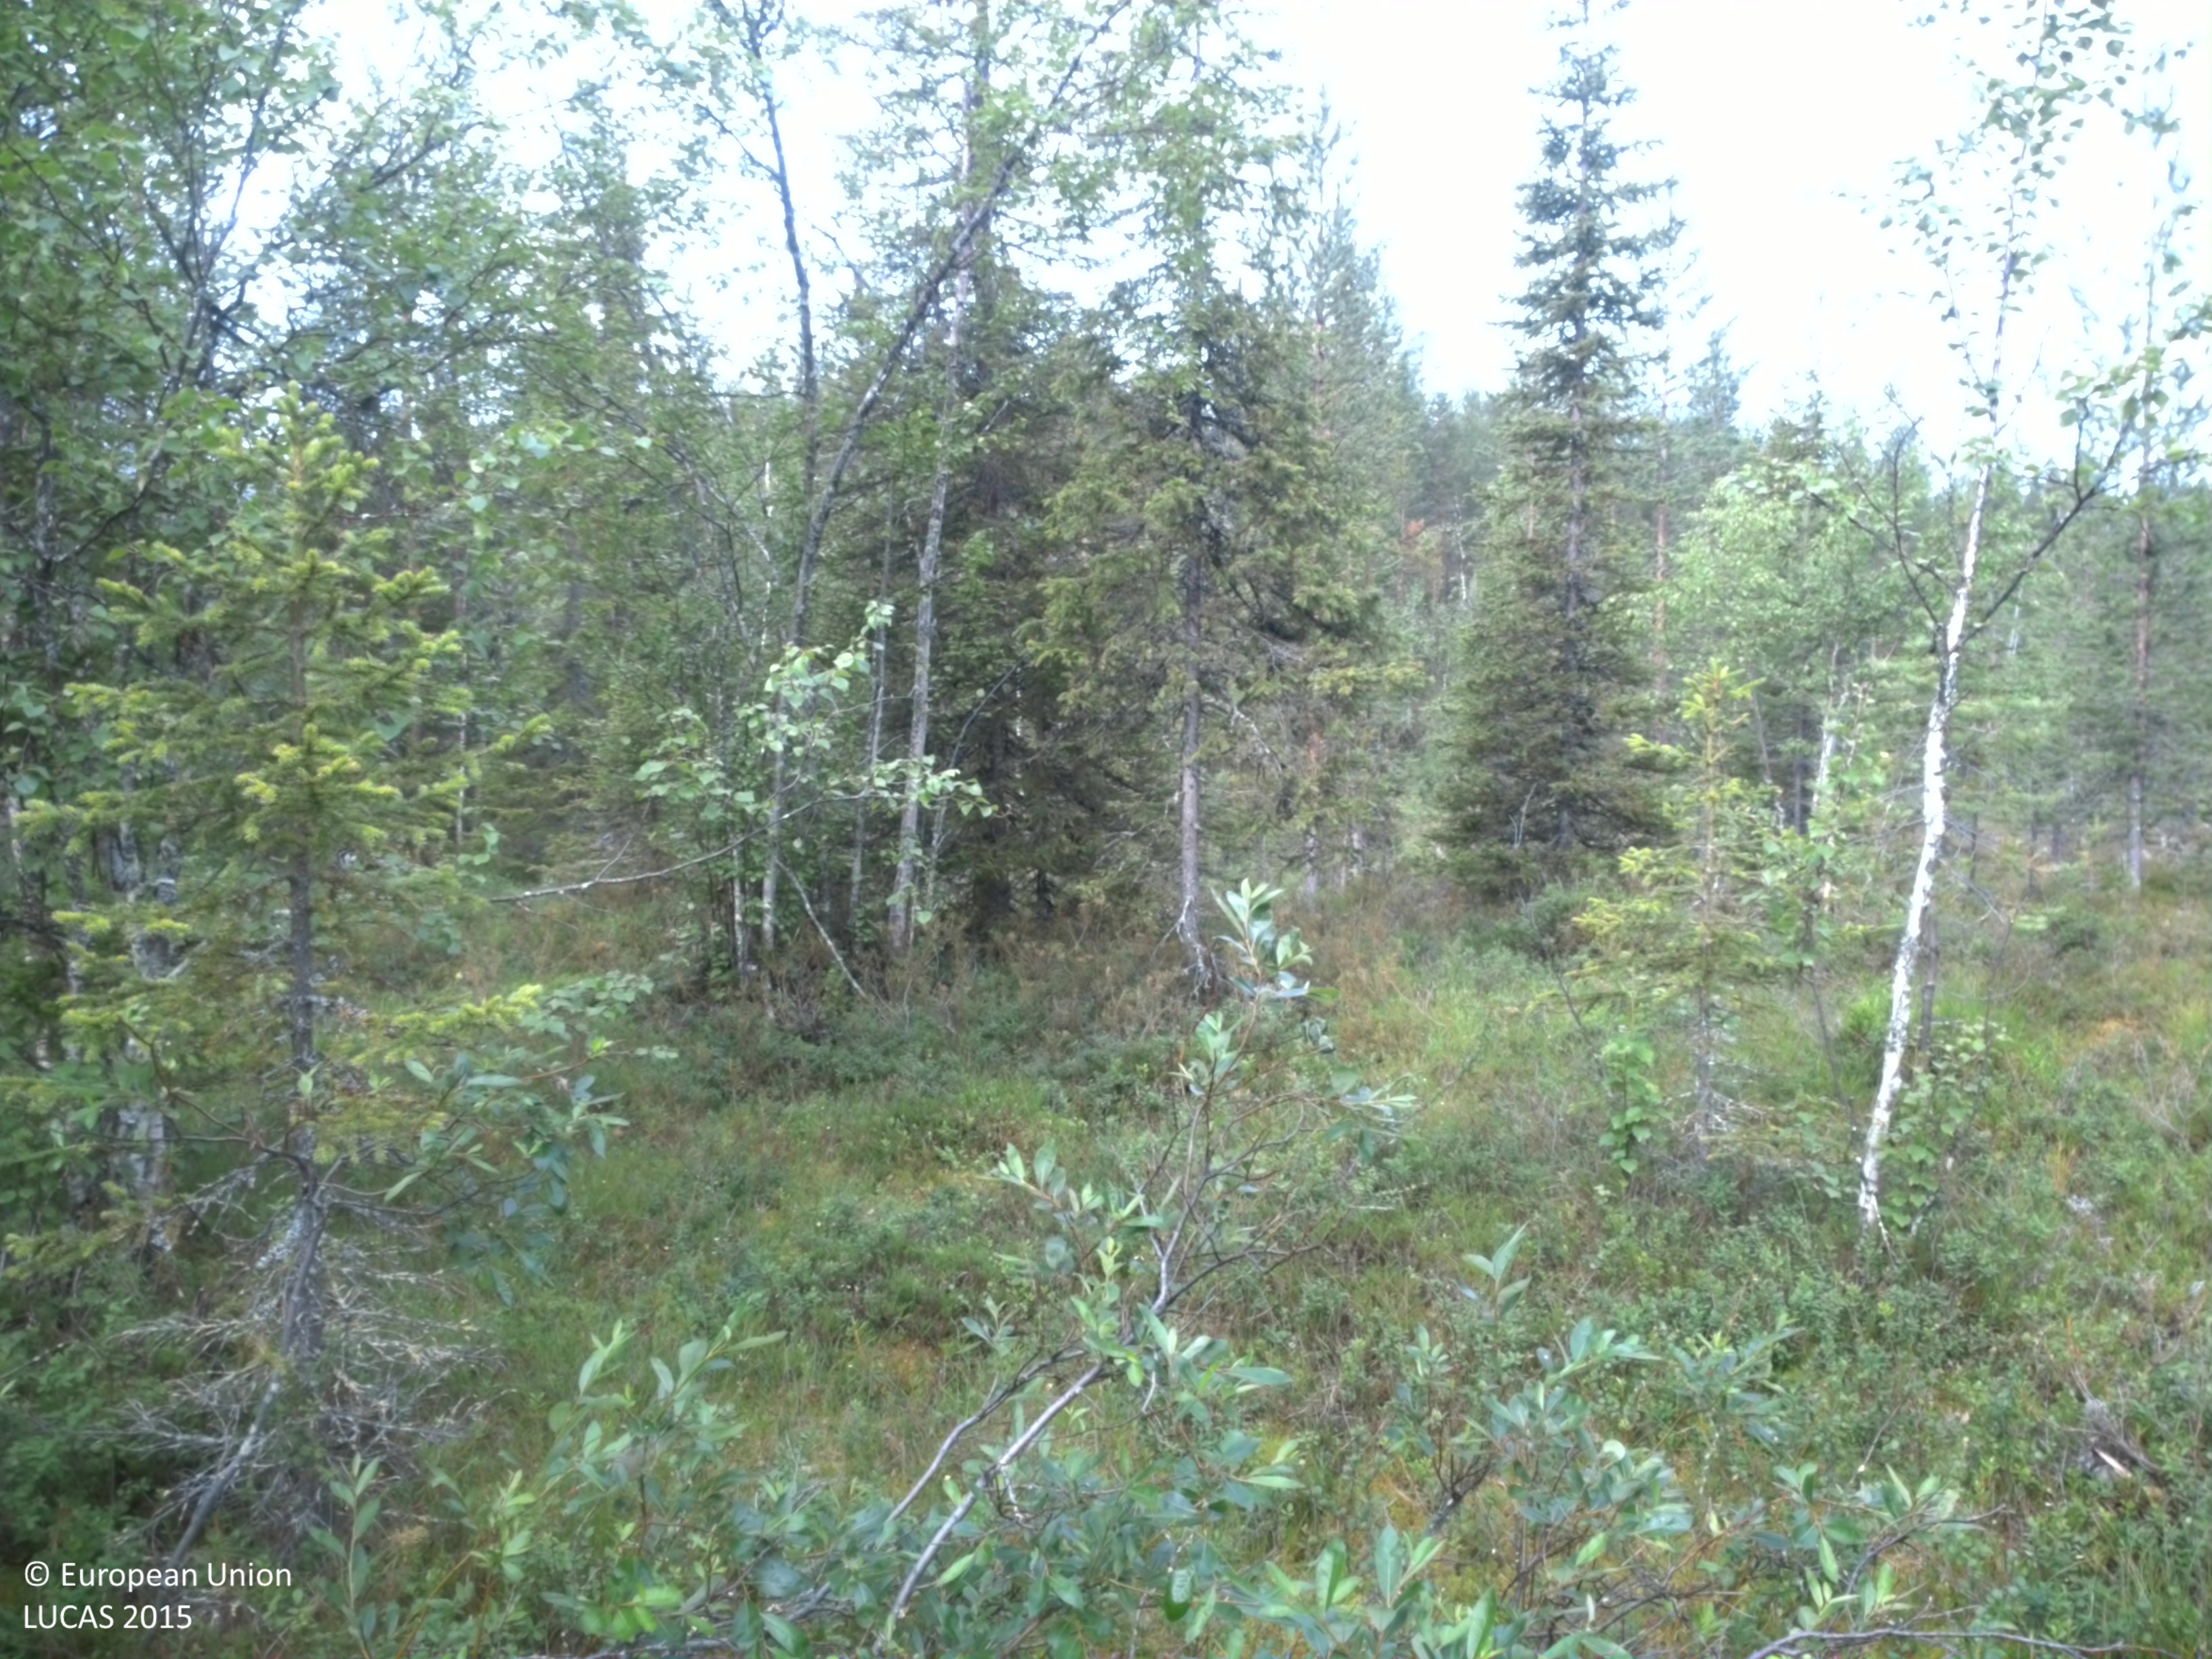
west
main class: Shrubland
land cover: Shrubland with sparse tree cover
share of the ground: > 75 %
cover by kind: shrubs 90 %, coniferous forest trees 5 %, lichens and mosses 5 %
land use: Forestry
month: August
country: SE
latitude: 66.0854
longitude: 19.7510
